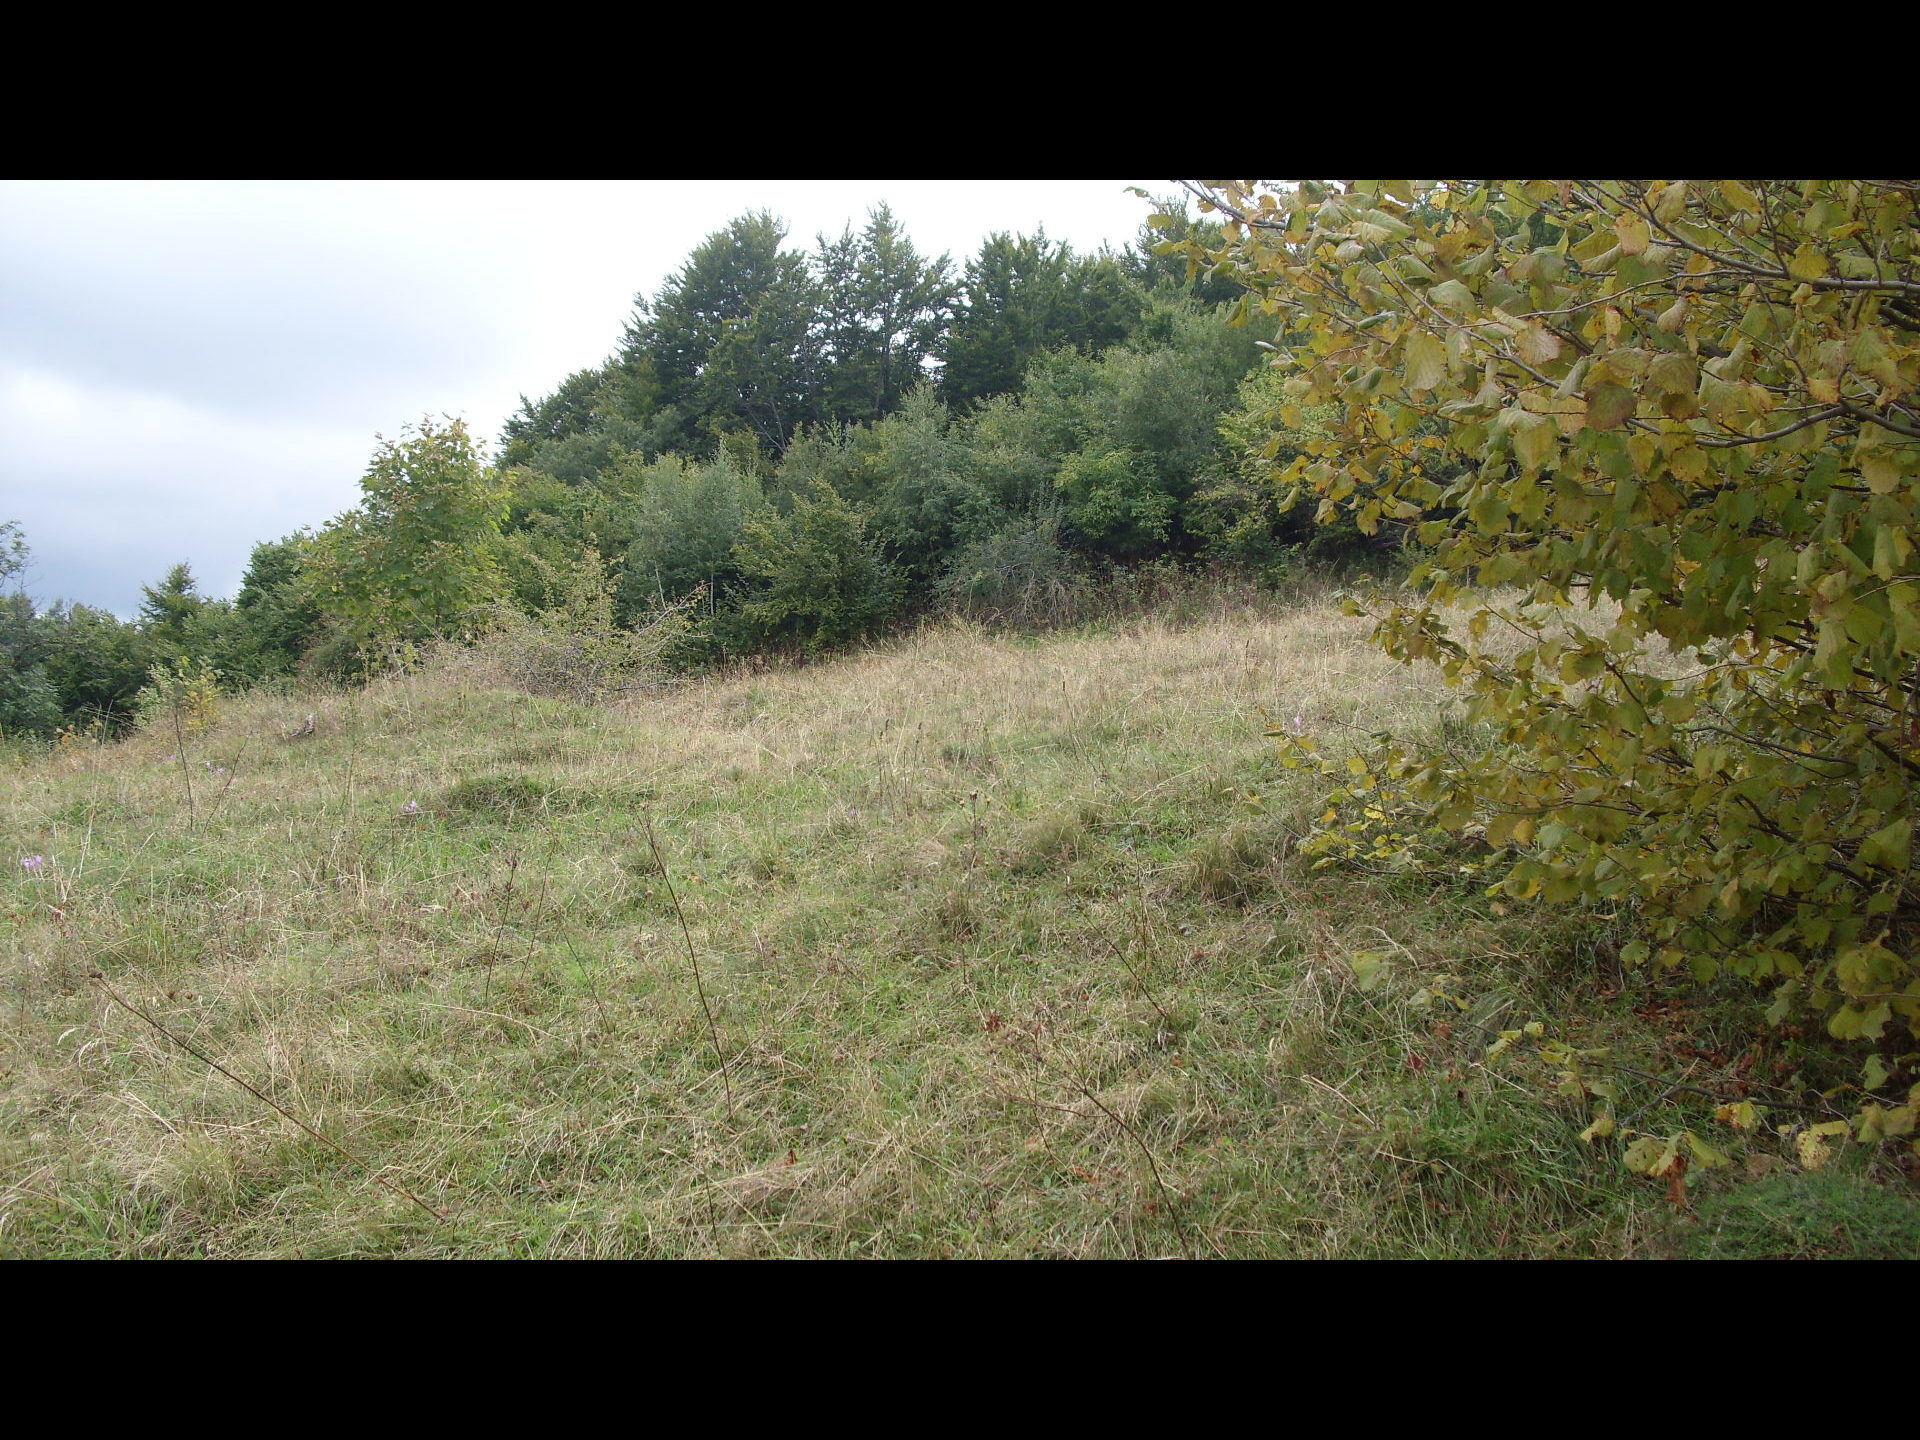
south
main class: Grassland
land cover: Grassland with sparse tree/shrub cover
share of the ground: > 75 %
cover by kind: herbaceous plants 90 %, broadleaved forest trees 5 %, shrubs 5 %
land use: Agriculture (excluding fallow land and kitchen gardens)
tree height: < 5 m
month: October
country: BG
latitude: 43.3470
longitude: 22.8512
